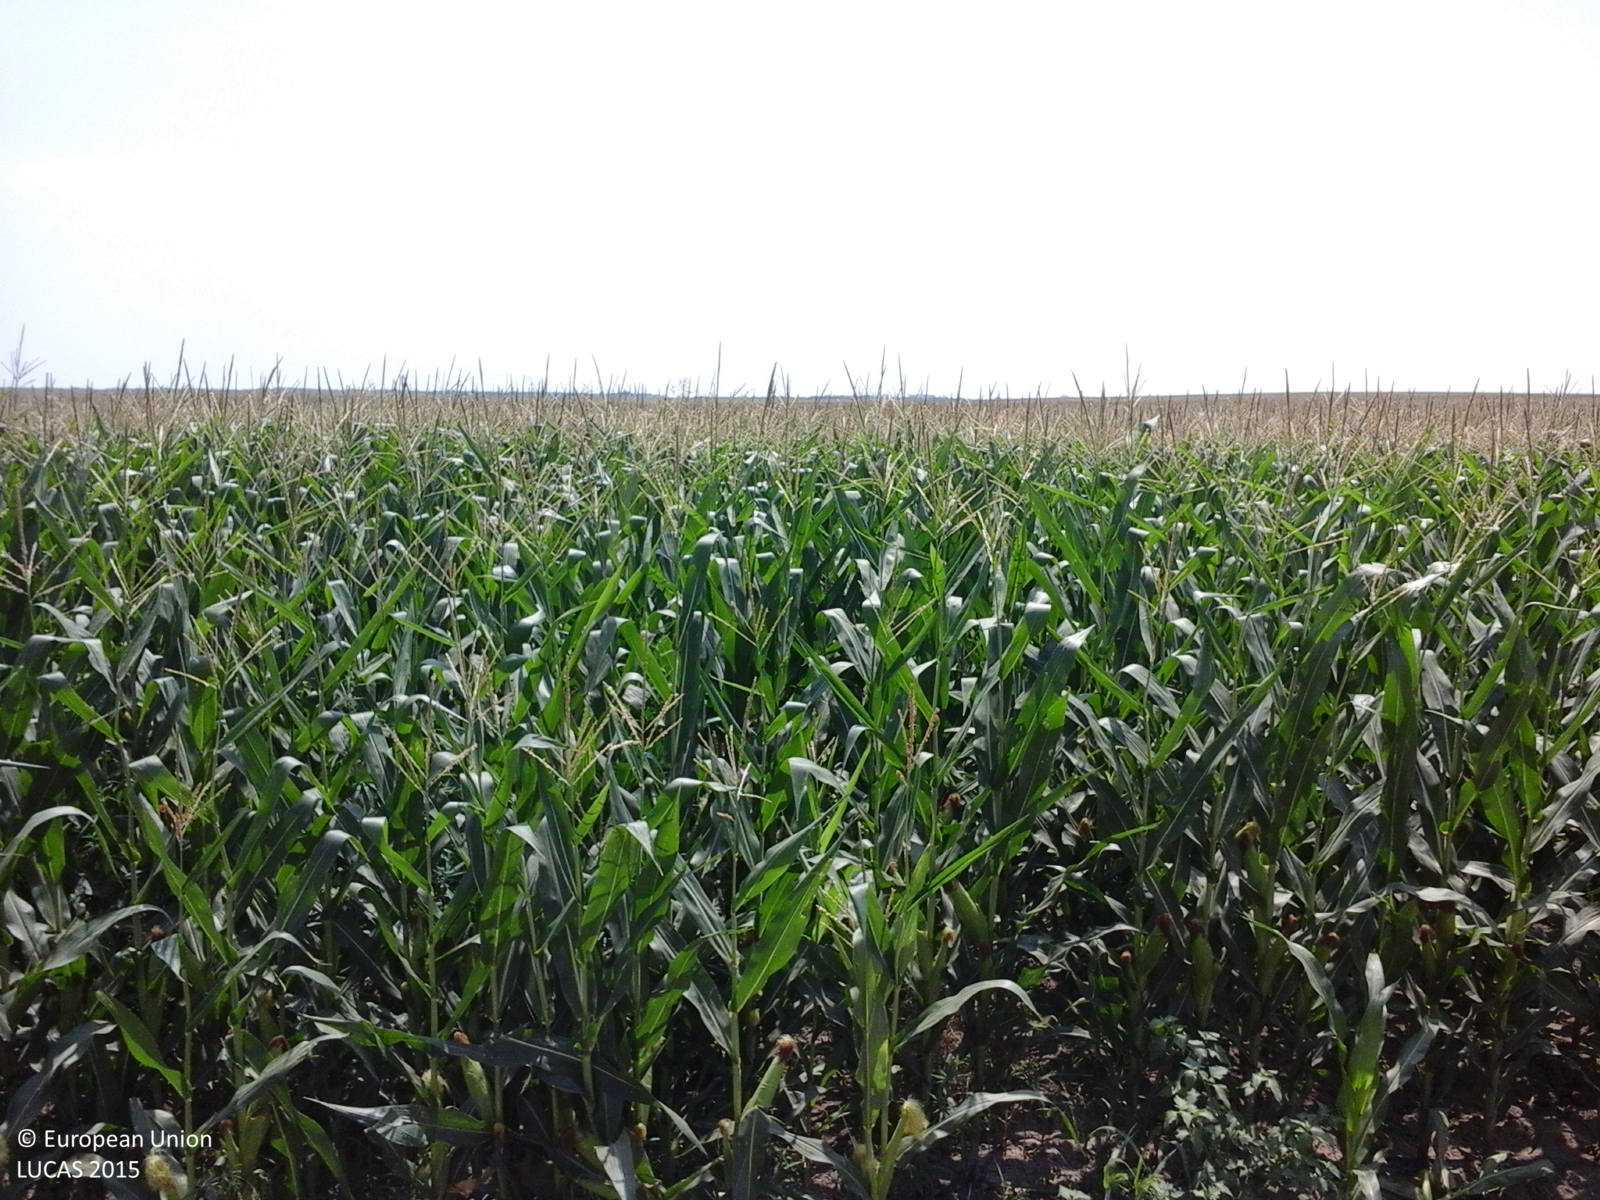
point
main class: Cropland
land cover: Maize
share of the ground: > 75 %
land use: Agriculture (excluding fallow land and kitchen gardens)
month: July
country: RO
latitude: 44.4748
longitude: 27.5818
